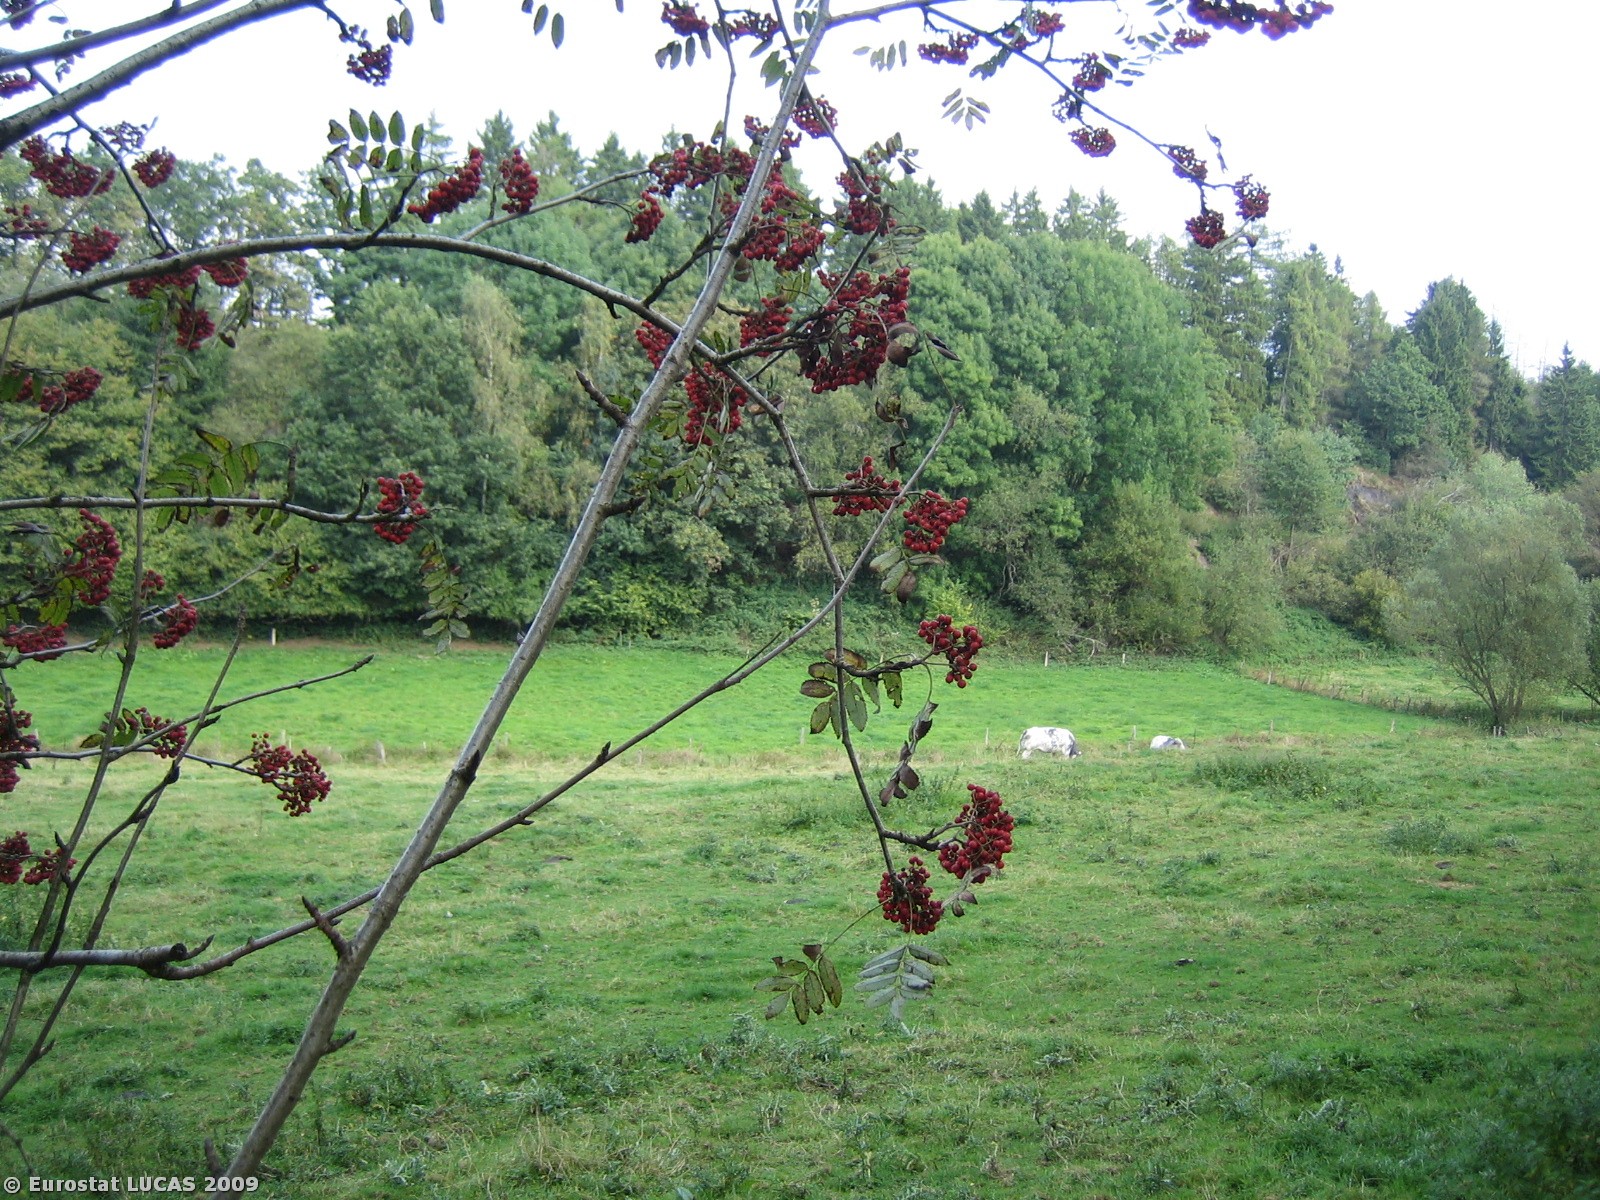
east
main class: Grassland
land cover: Grassland without tree/shrub cover
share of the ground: > 75 %
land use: Agriculture (excluding fallow land and kitchen gardens)
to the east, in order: Grassland without tree/shrub cover; Fences; Ditches and canals; Fences; Grassland without tree/shrub cover; Fences; Broadleaved woodland; Grass margins; Paved roads, cycling and walking lanes; Grass margins; Mixed woodland; Fences; Maize; Fences; Coniferous woodland
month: September
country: BE
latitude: 50.1182
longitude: 5.6210
